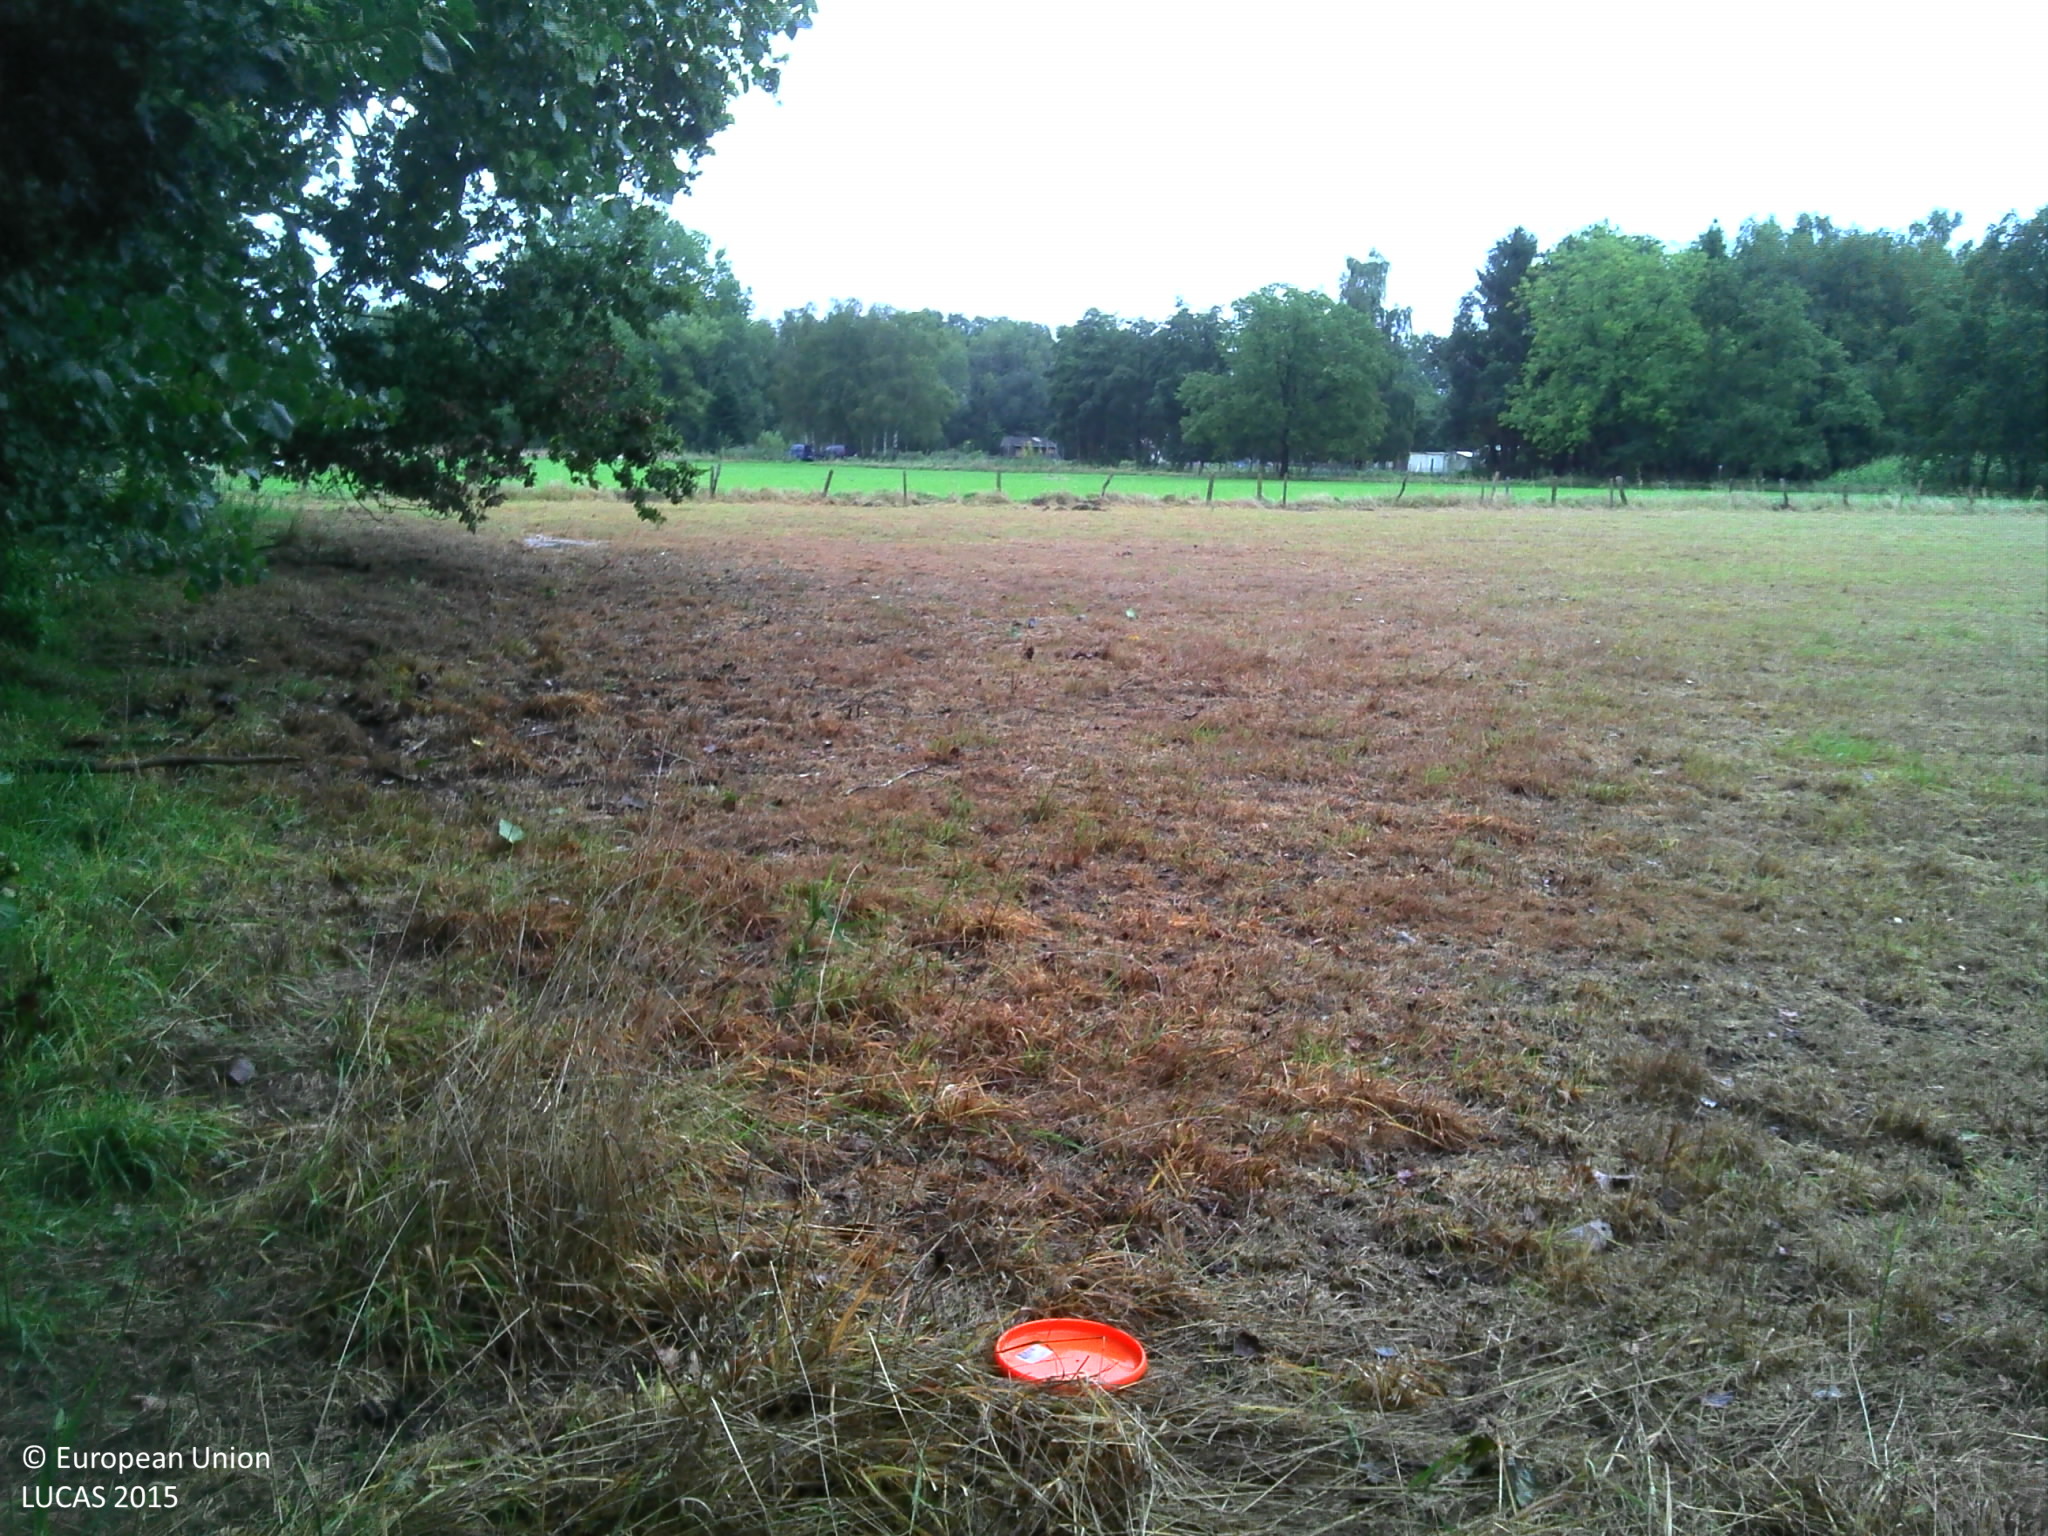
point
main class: Grassland
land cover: Grassland without tree/shrub cover
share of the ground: > 75 %
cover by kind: herbaceous plants 100 %
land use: Agriculture (excluding fallow land and kitchen gardens)
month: September
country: BE
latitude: 51.2481
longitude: 4.6524
